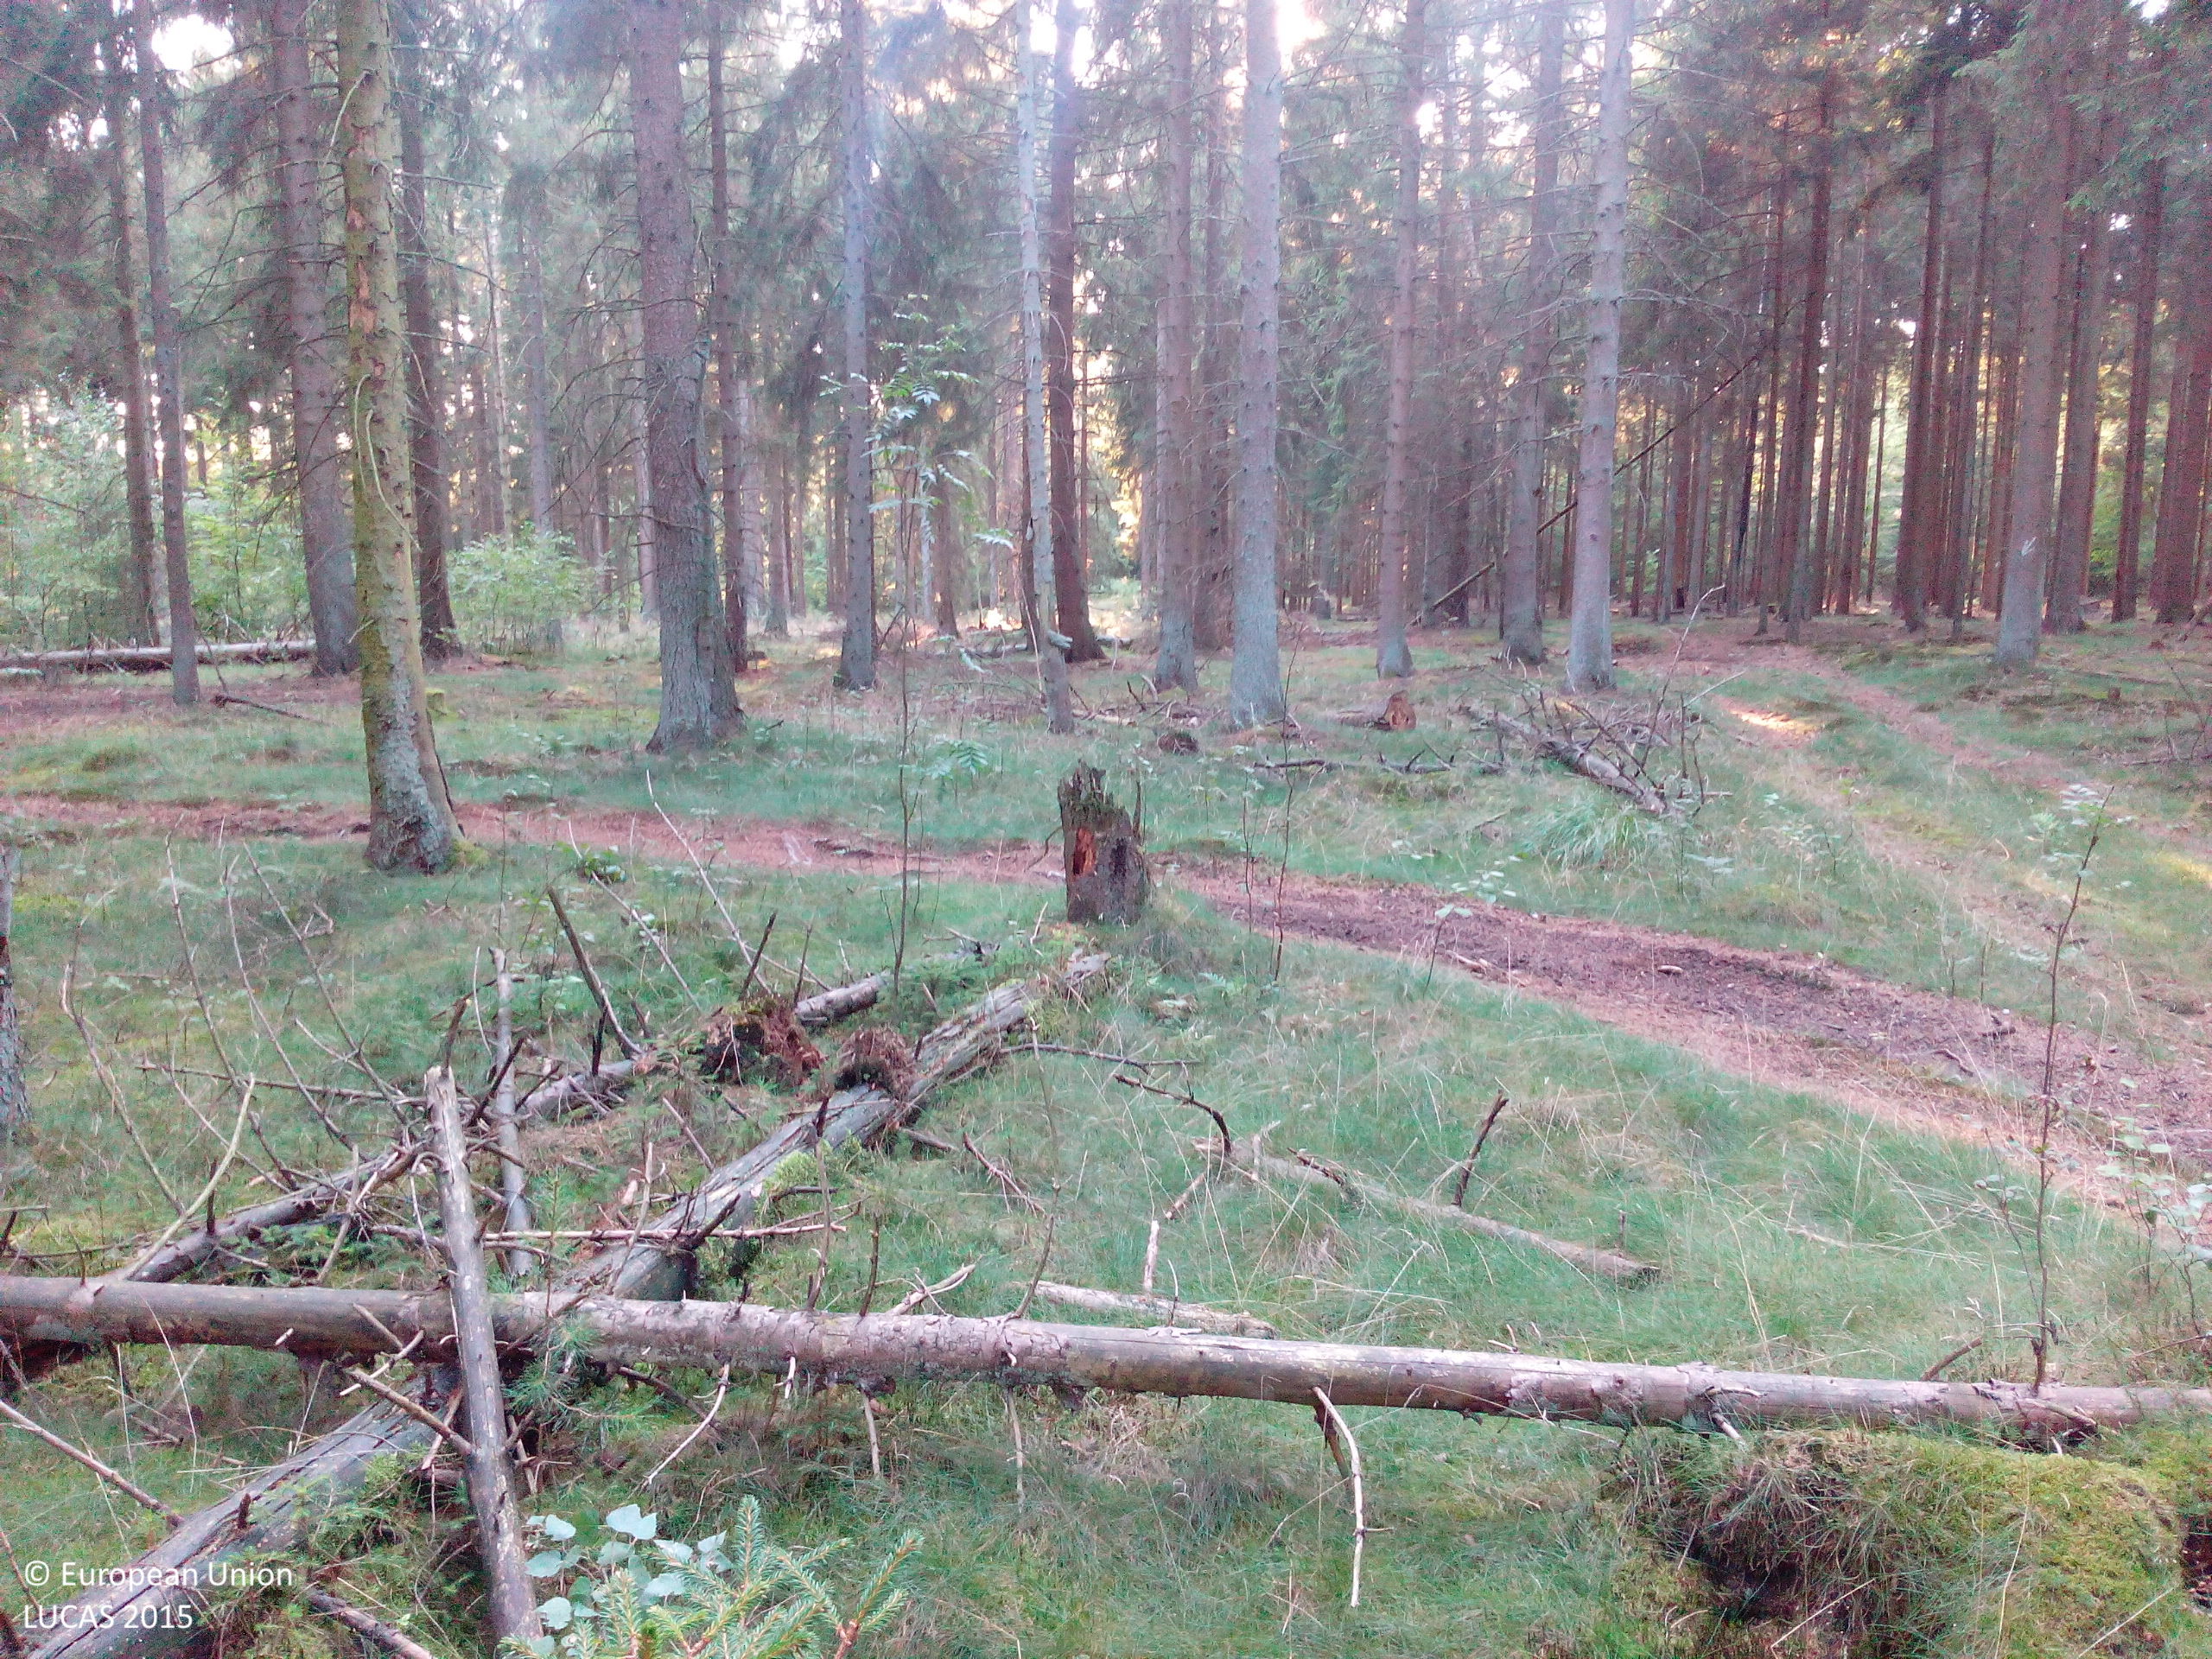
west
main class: Woodland
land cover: Spruce dominated coniferous woodland
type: hemiboreal forest and nemoral coniferous forest and mixed broadleaved-coniferous forest
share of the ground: > 75 %
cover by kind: coniferous forest trees 75 %, herbaceous plants 20 %, unconsolidated bare surface 5 %
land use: Forestry
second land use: Amenities, museums, leisure
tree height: > 5 m
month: August
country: DE
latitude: 53.8152
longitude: 9.8937
